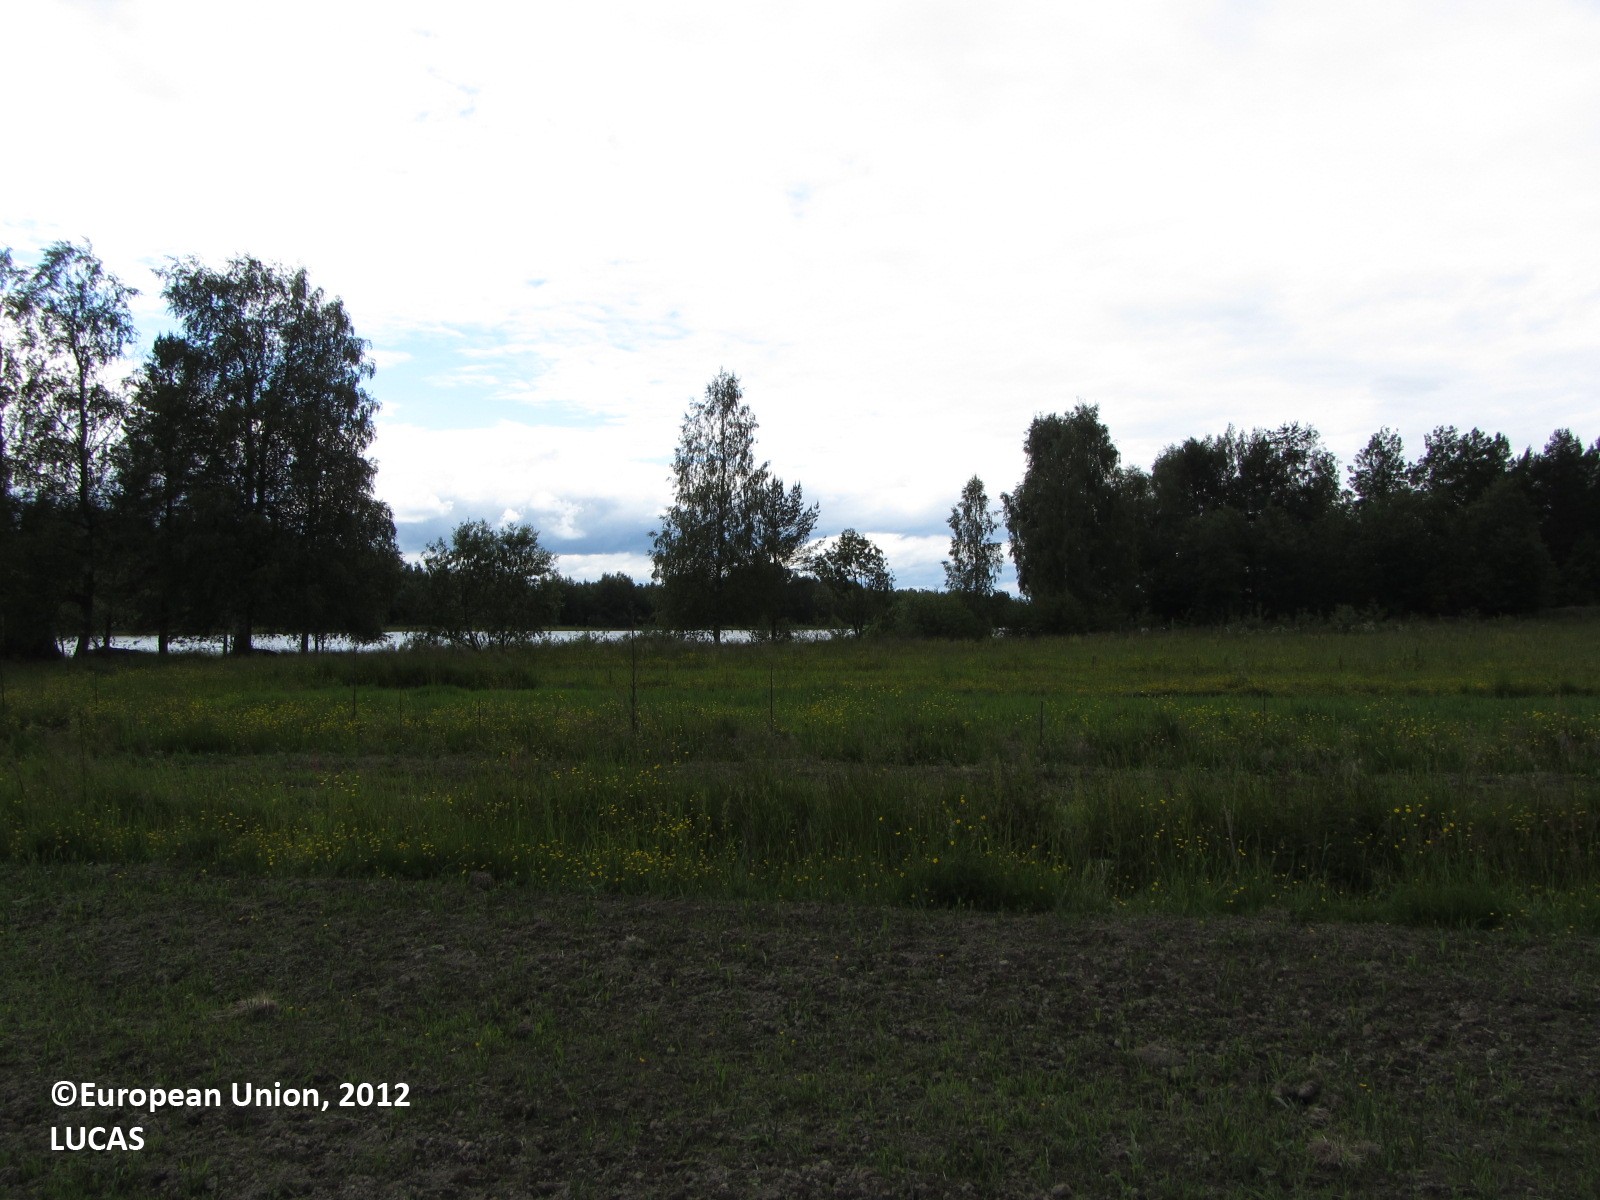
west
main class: Grassland
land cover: Grassland without tree/shrub cover
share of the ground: > 75 %
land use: Agriculture (excluding fallow land and kitchen gardens)
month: June
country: FI
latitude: 62.7595
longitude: 25.5214
